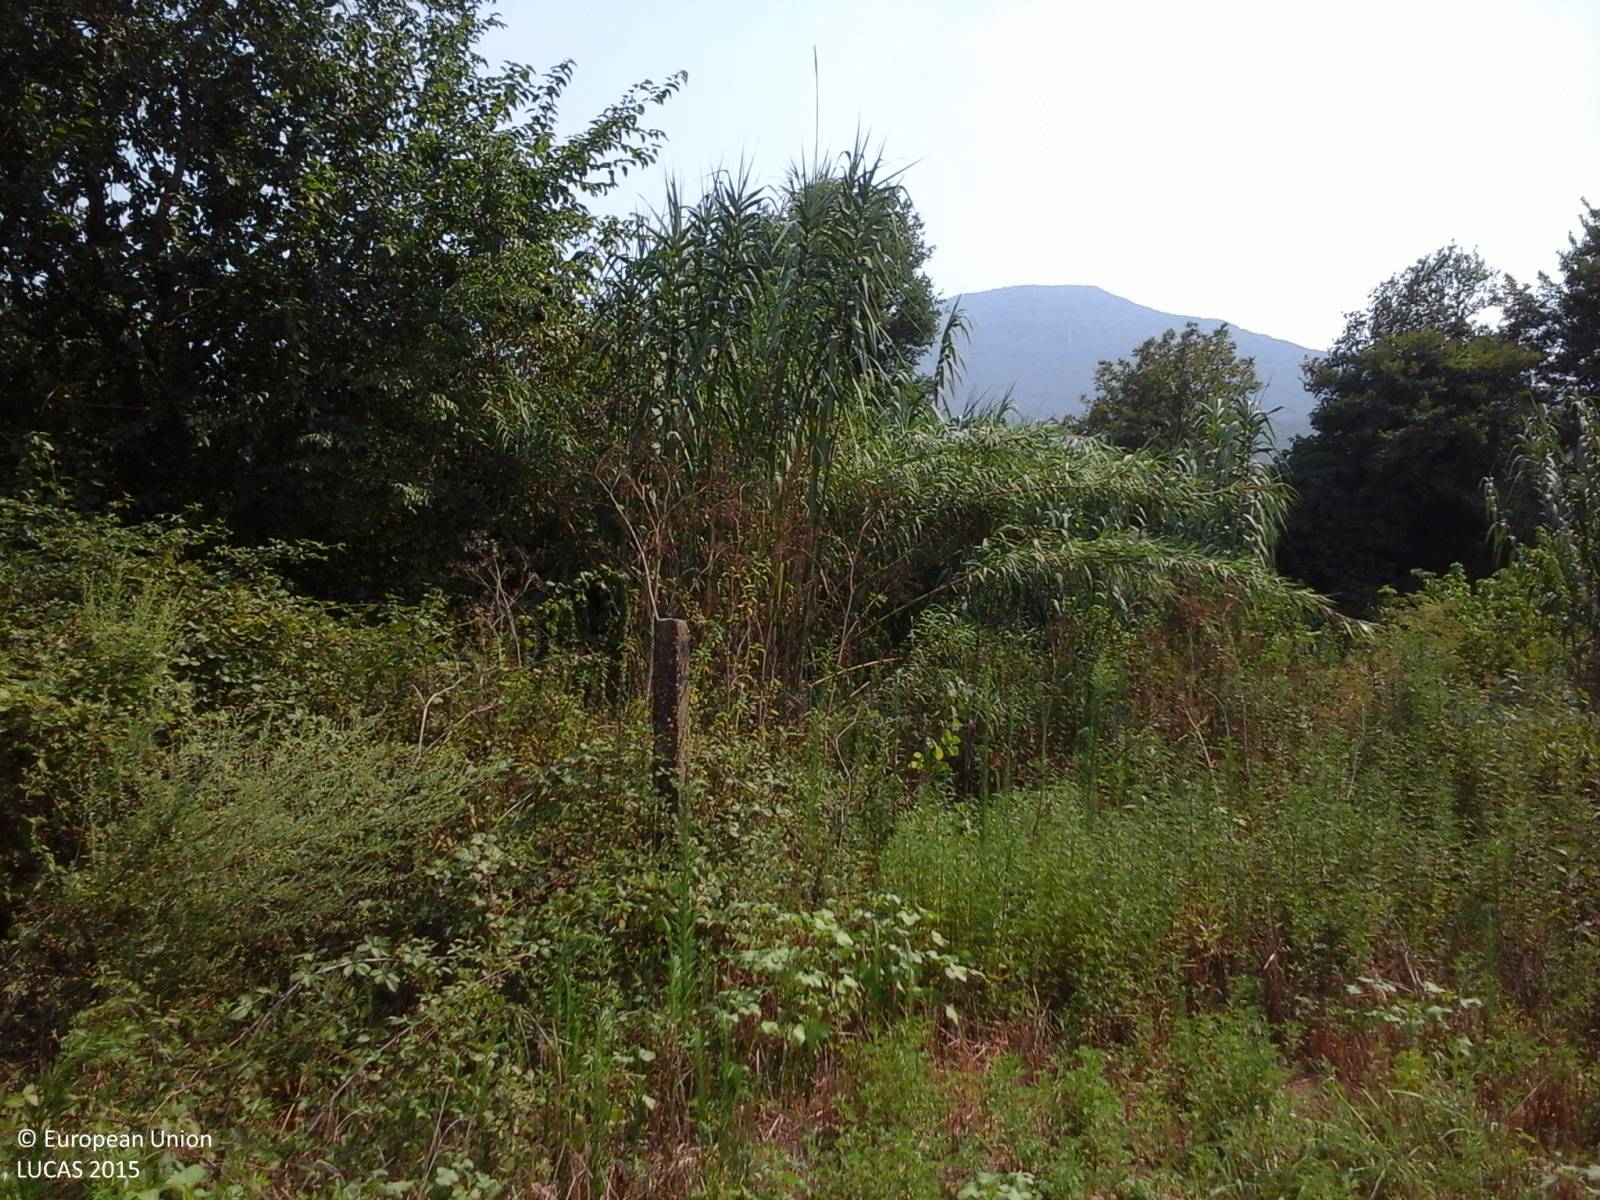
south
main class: Woodland
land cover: Broadleaved woodland
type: thermophilous deciduous forest
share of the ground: > 75 %
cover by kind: broadleaved forest trees 90 %, shrubs 10 %
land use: Semi-natural and natural areas not in use
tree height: > 5 m
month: August
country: IT
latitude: 41.4295
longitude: 13.6834
